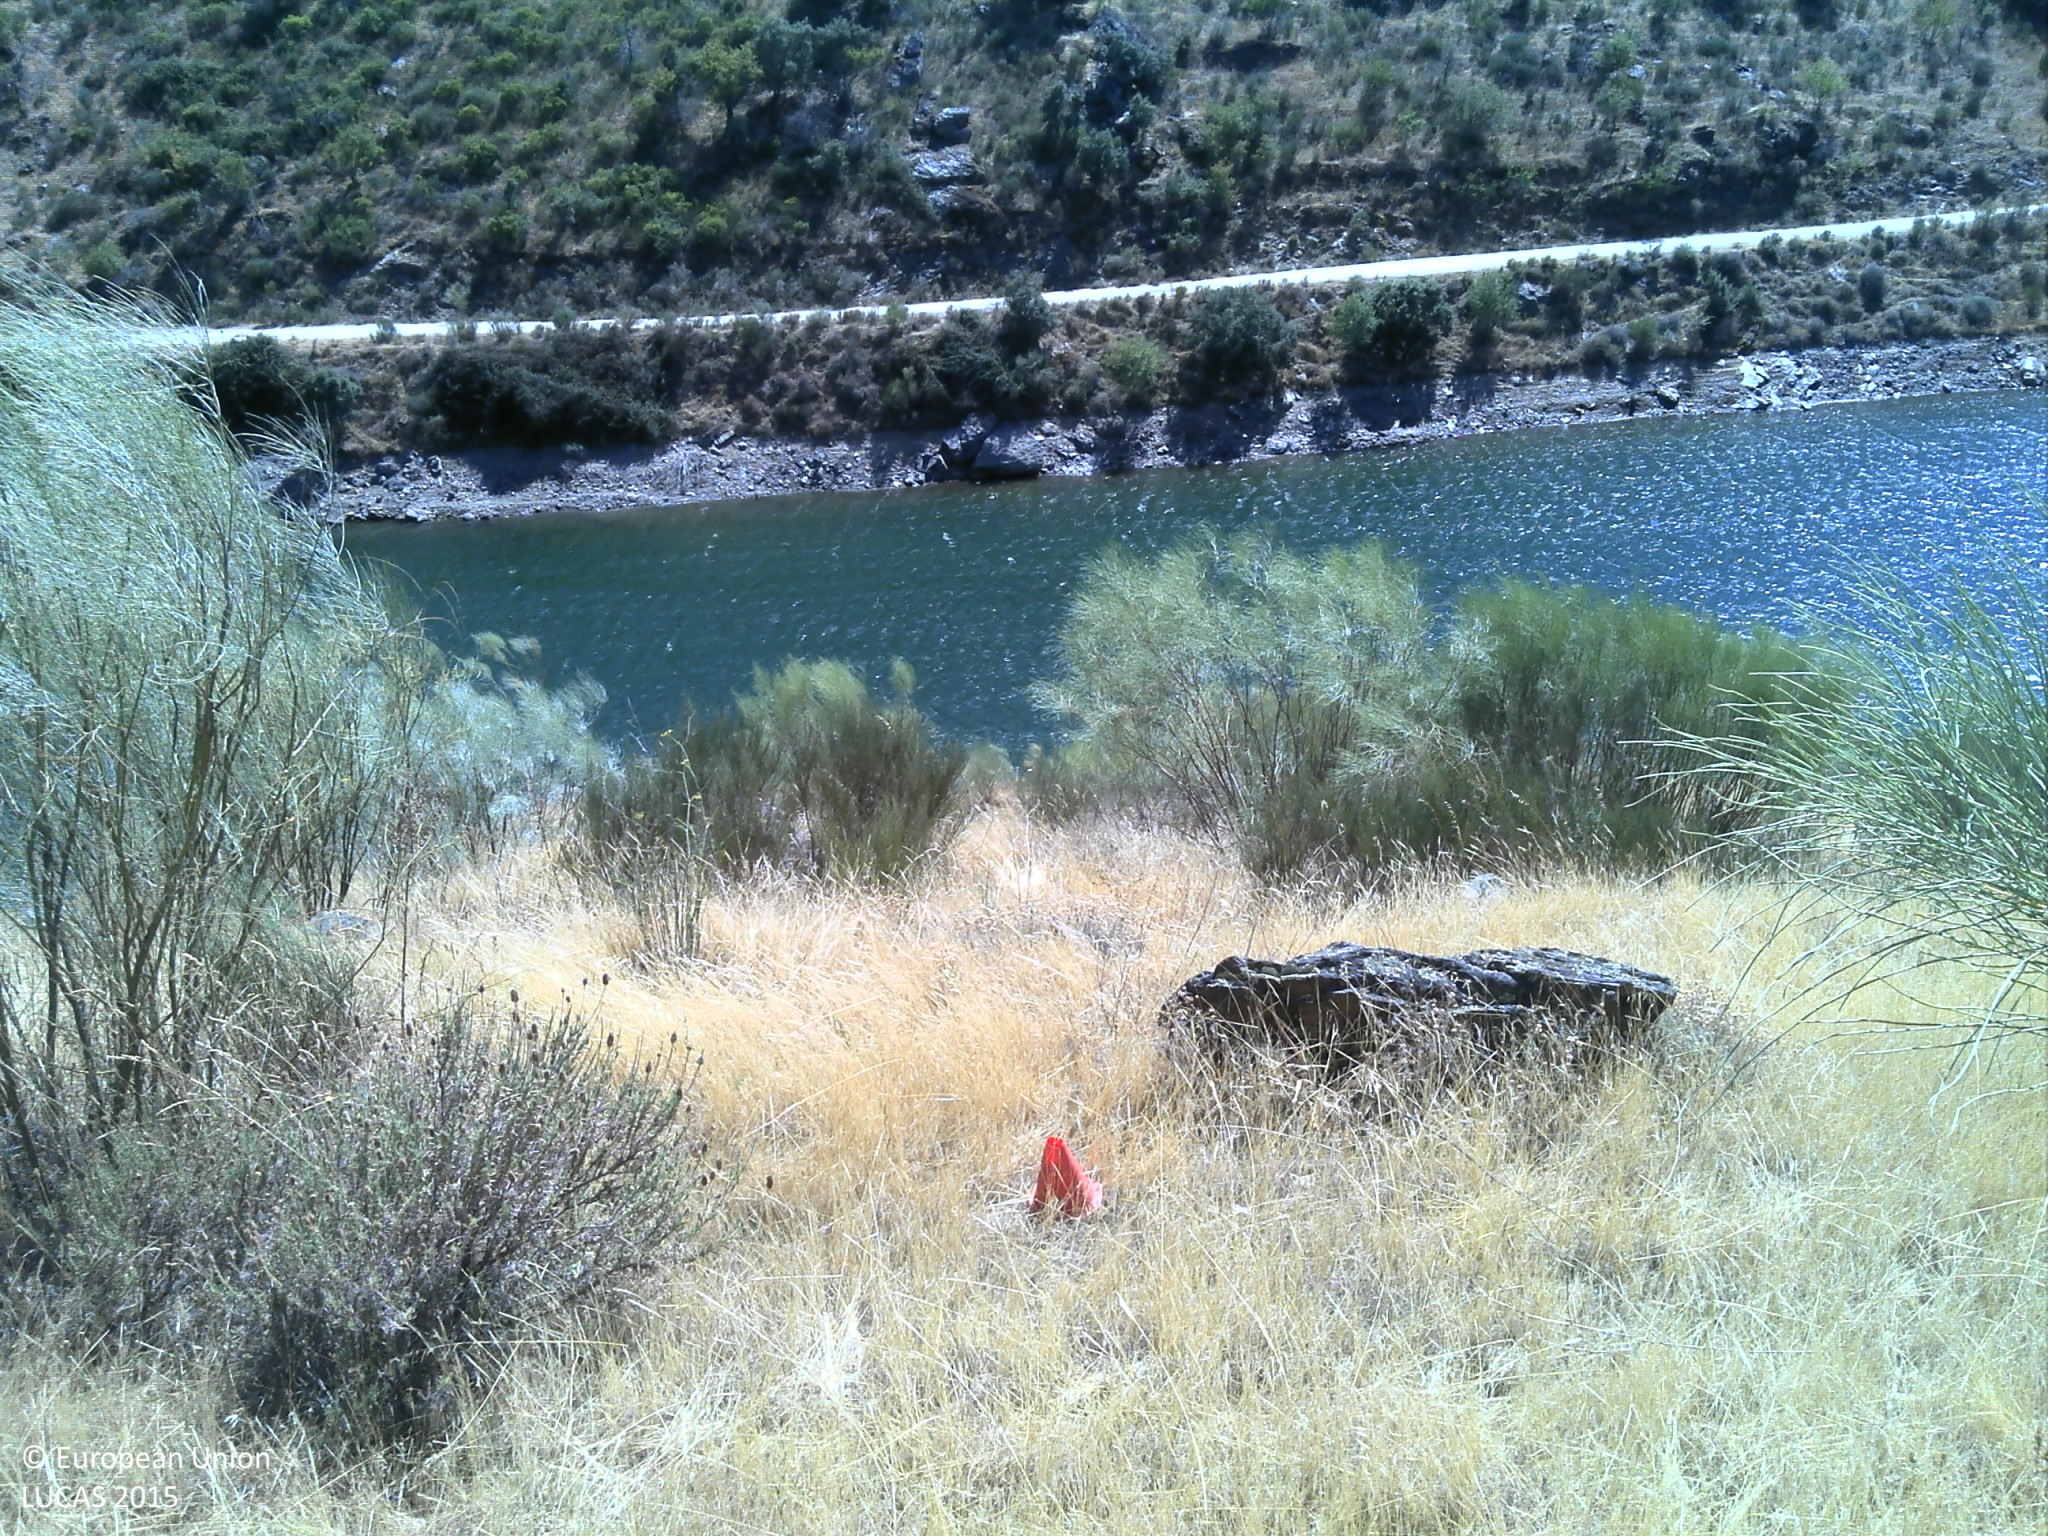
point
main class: Shrubland
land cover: Shrubland without tree cover
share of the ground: 25 - 50 %
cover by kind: herbaceous plants 55 %, shrubs 30 %, unconsolidated bare surface 10 %, consolidated bare surface 5 %
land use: Abandoned areas
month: July
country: PT
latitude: 41.3301
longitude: -7.0193
